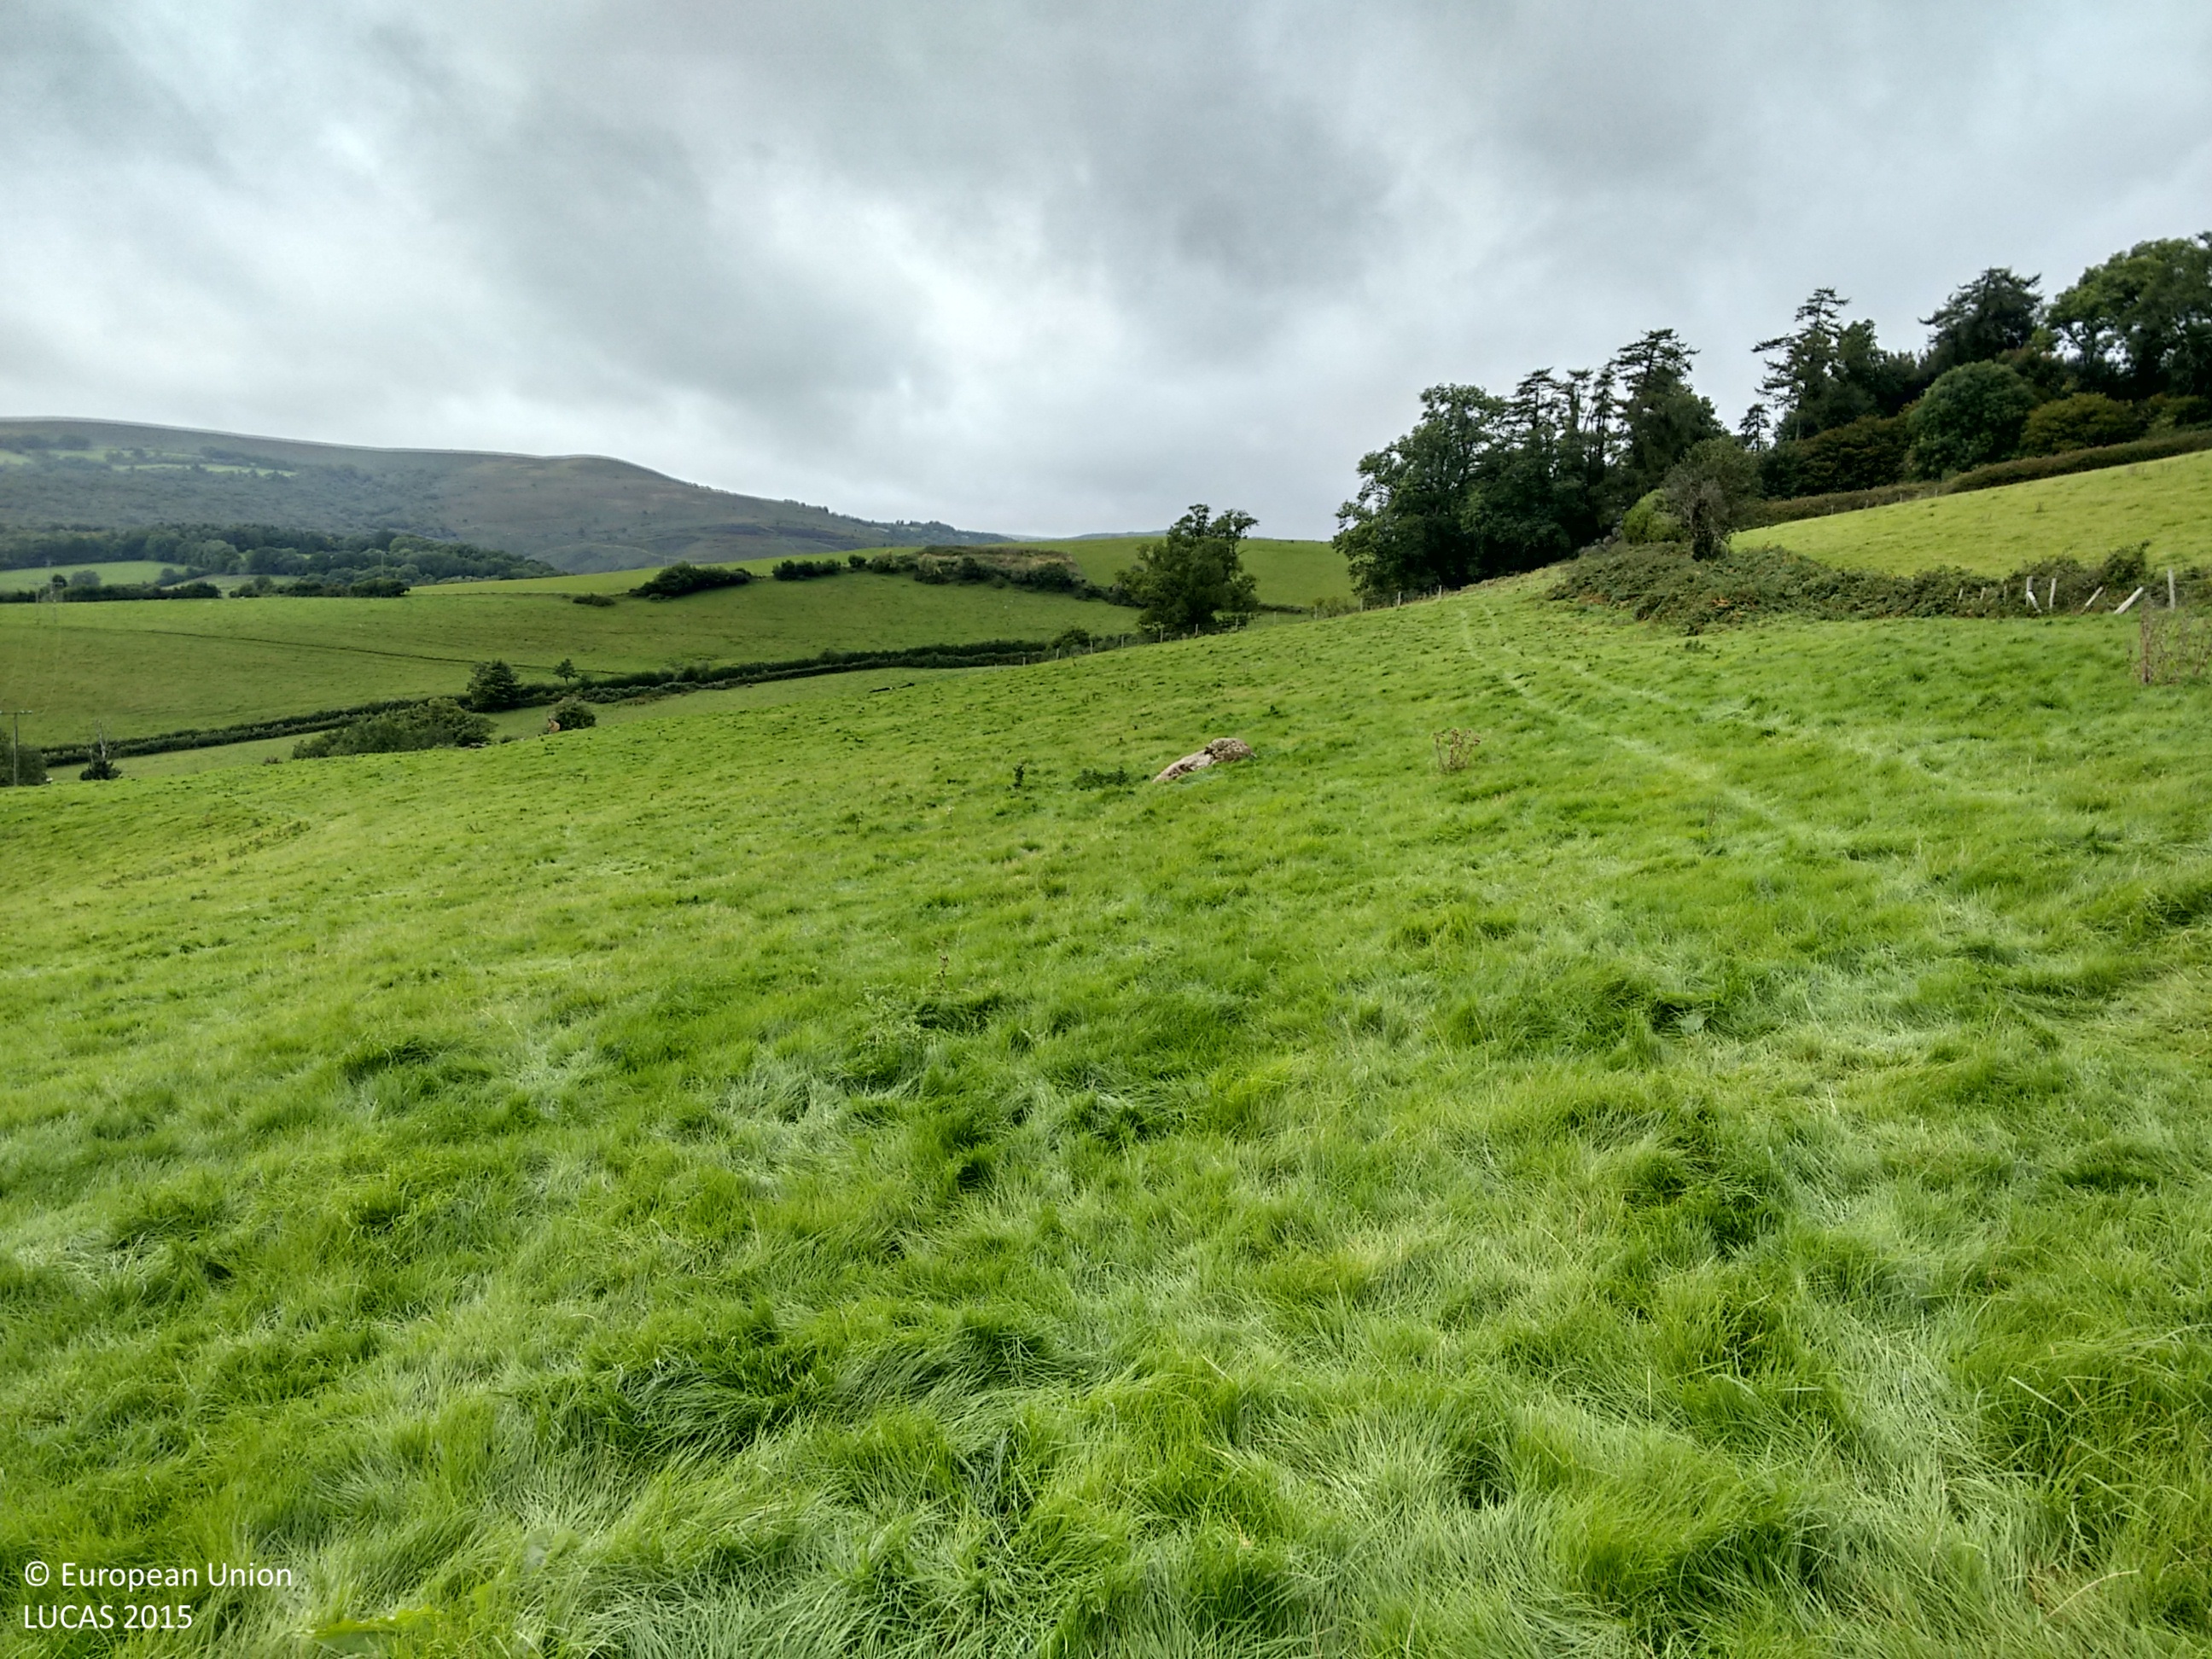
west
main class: Grassland
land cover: Grassland without tree/shrub cover
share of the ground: > 75 %
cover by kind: herbaceous plants 100 %
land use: Agriculture (excluding fallow land and kitchen gardens)
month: September
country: GB
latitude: 50.6115
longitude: -3.6965
